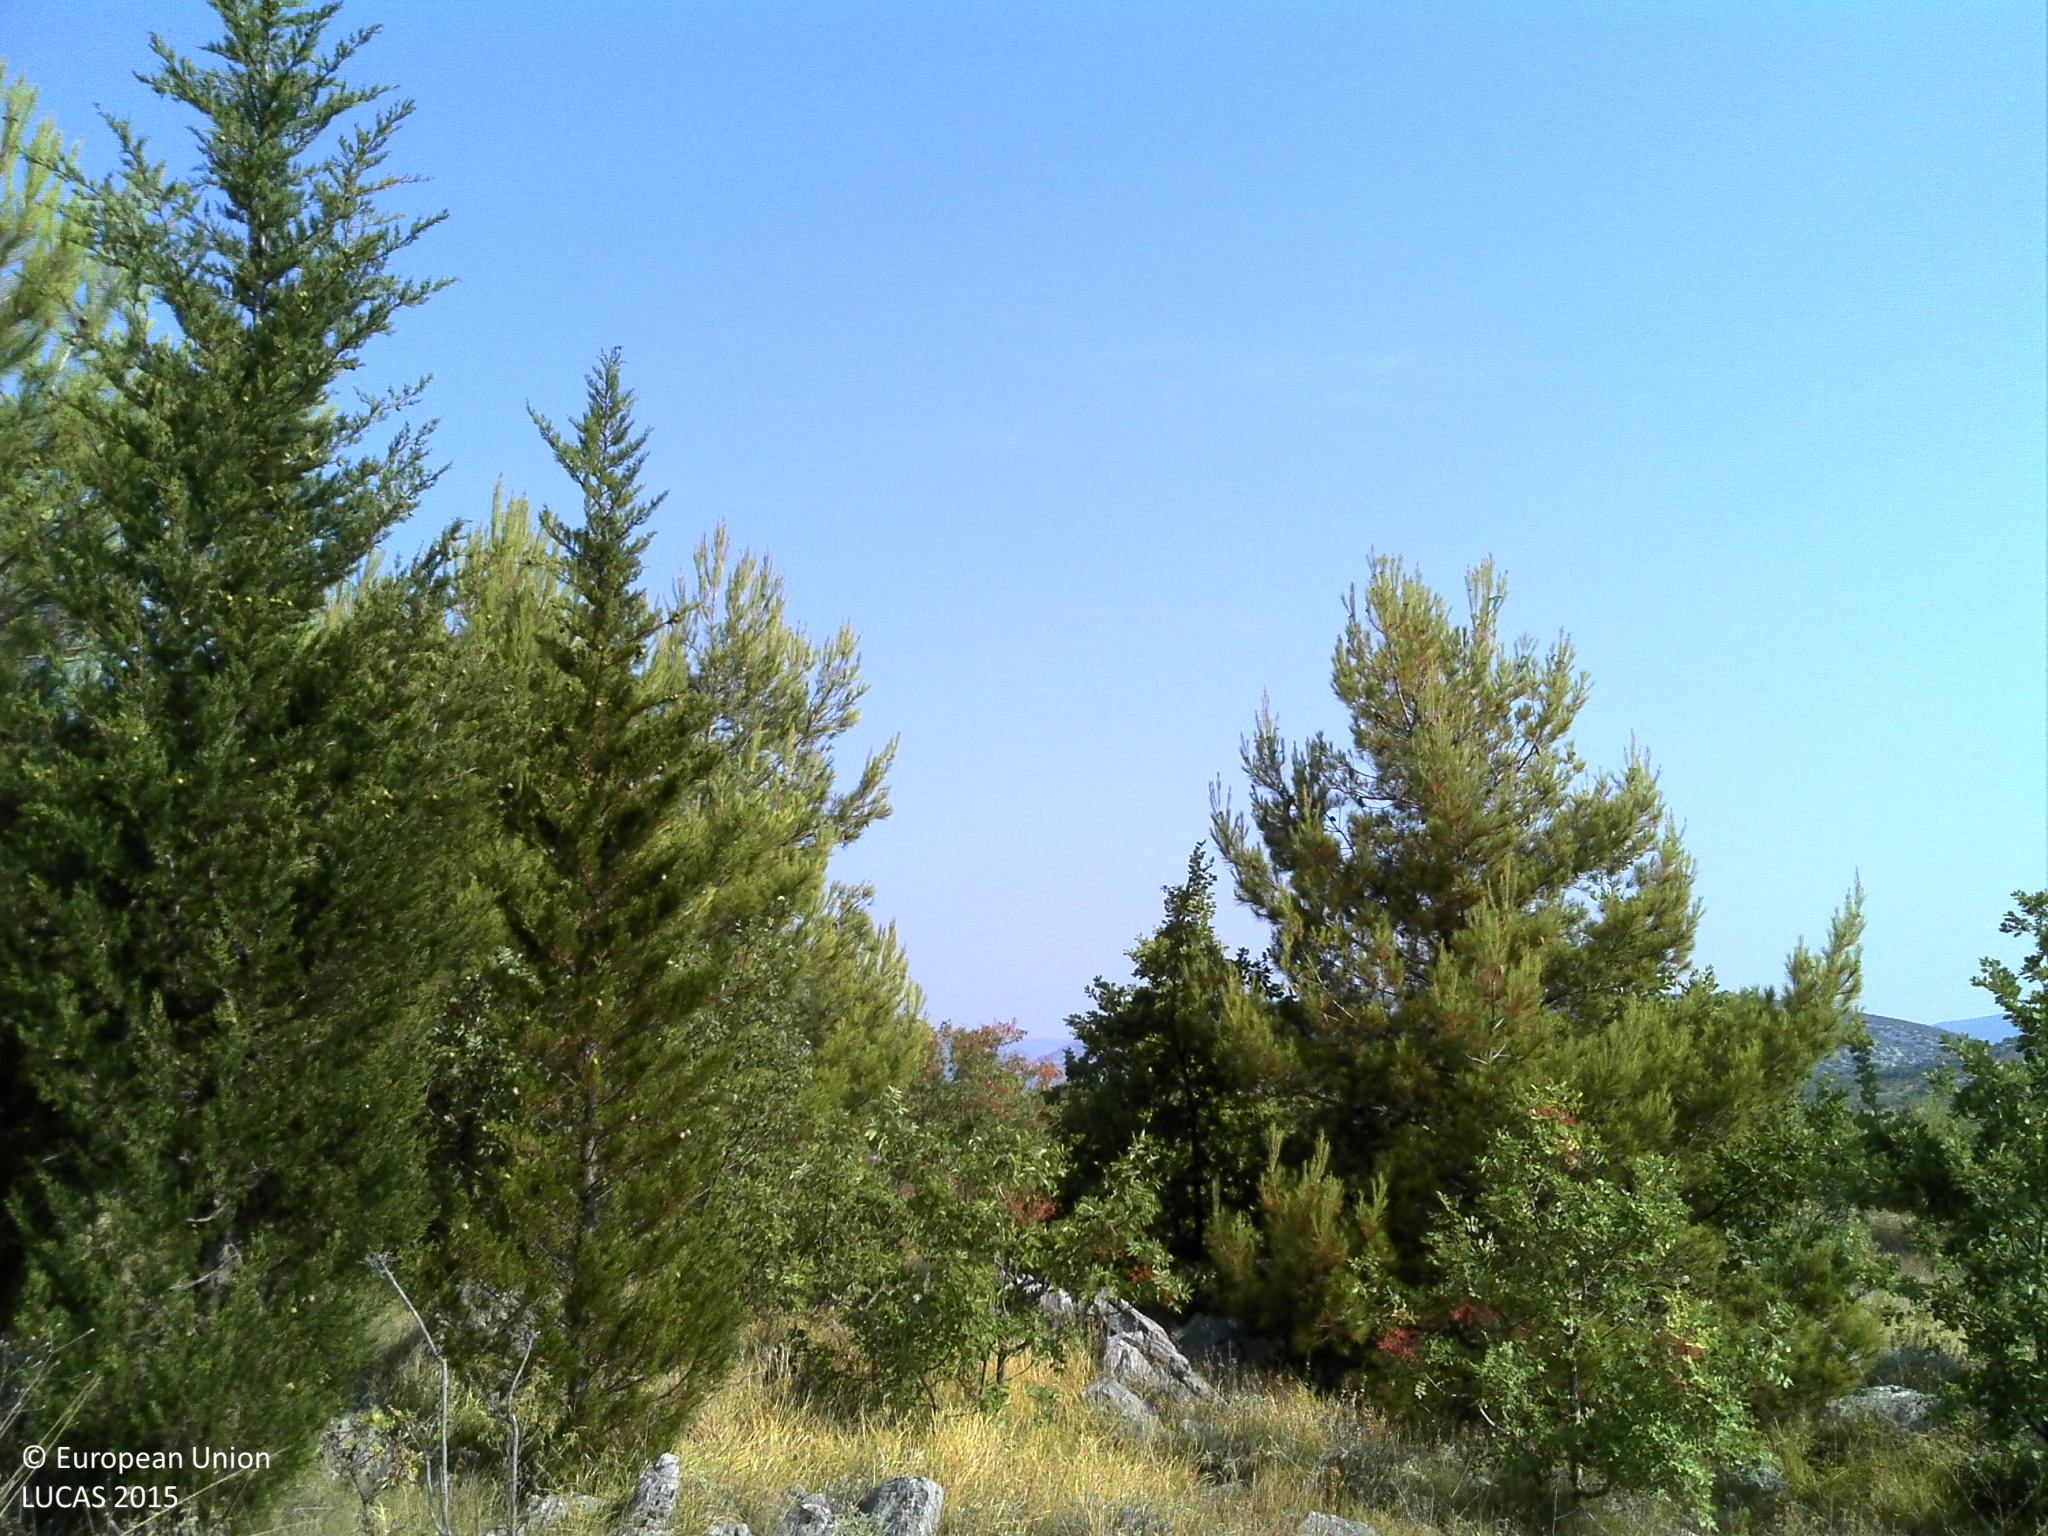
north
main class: Woodland
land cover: Pine dominated coniferous woodland
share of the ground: 10 - 25 %
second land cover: Grassland without tree/shrub cover
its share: > 75 %
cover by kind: consolidated bare surface 35 %, herbaceous plants 30 %, coniferous forest trees 25 %, shrubs 10 %
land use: Agriculture (excluding fallow land and kitchen gardens)
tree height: > 5 m
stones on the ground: 25 - 50 %
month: July
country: HR
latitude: 42.8239
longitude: 17.8065
